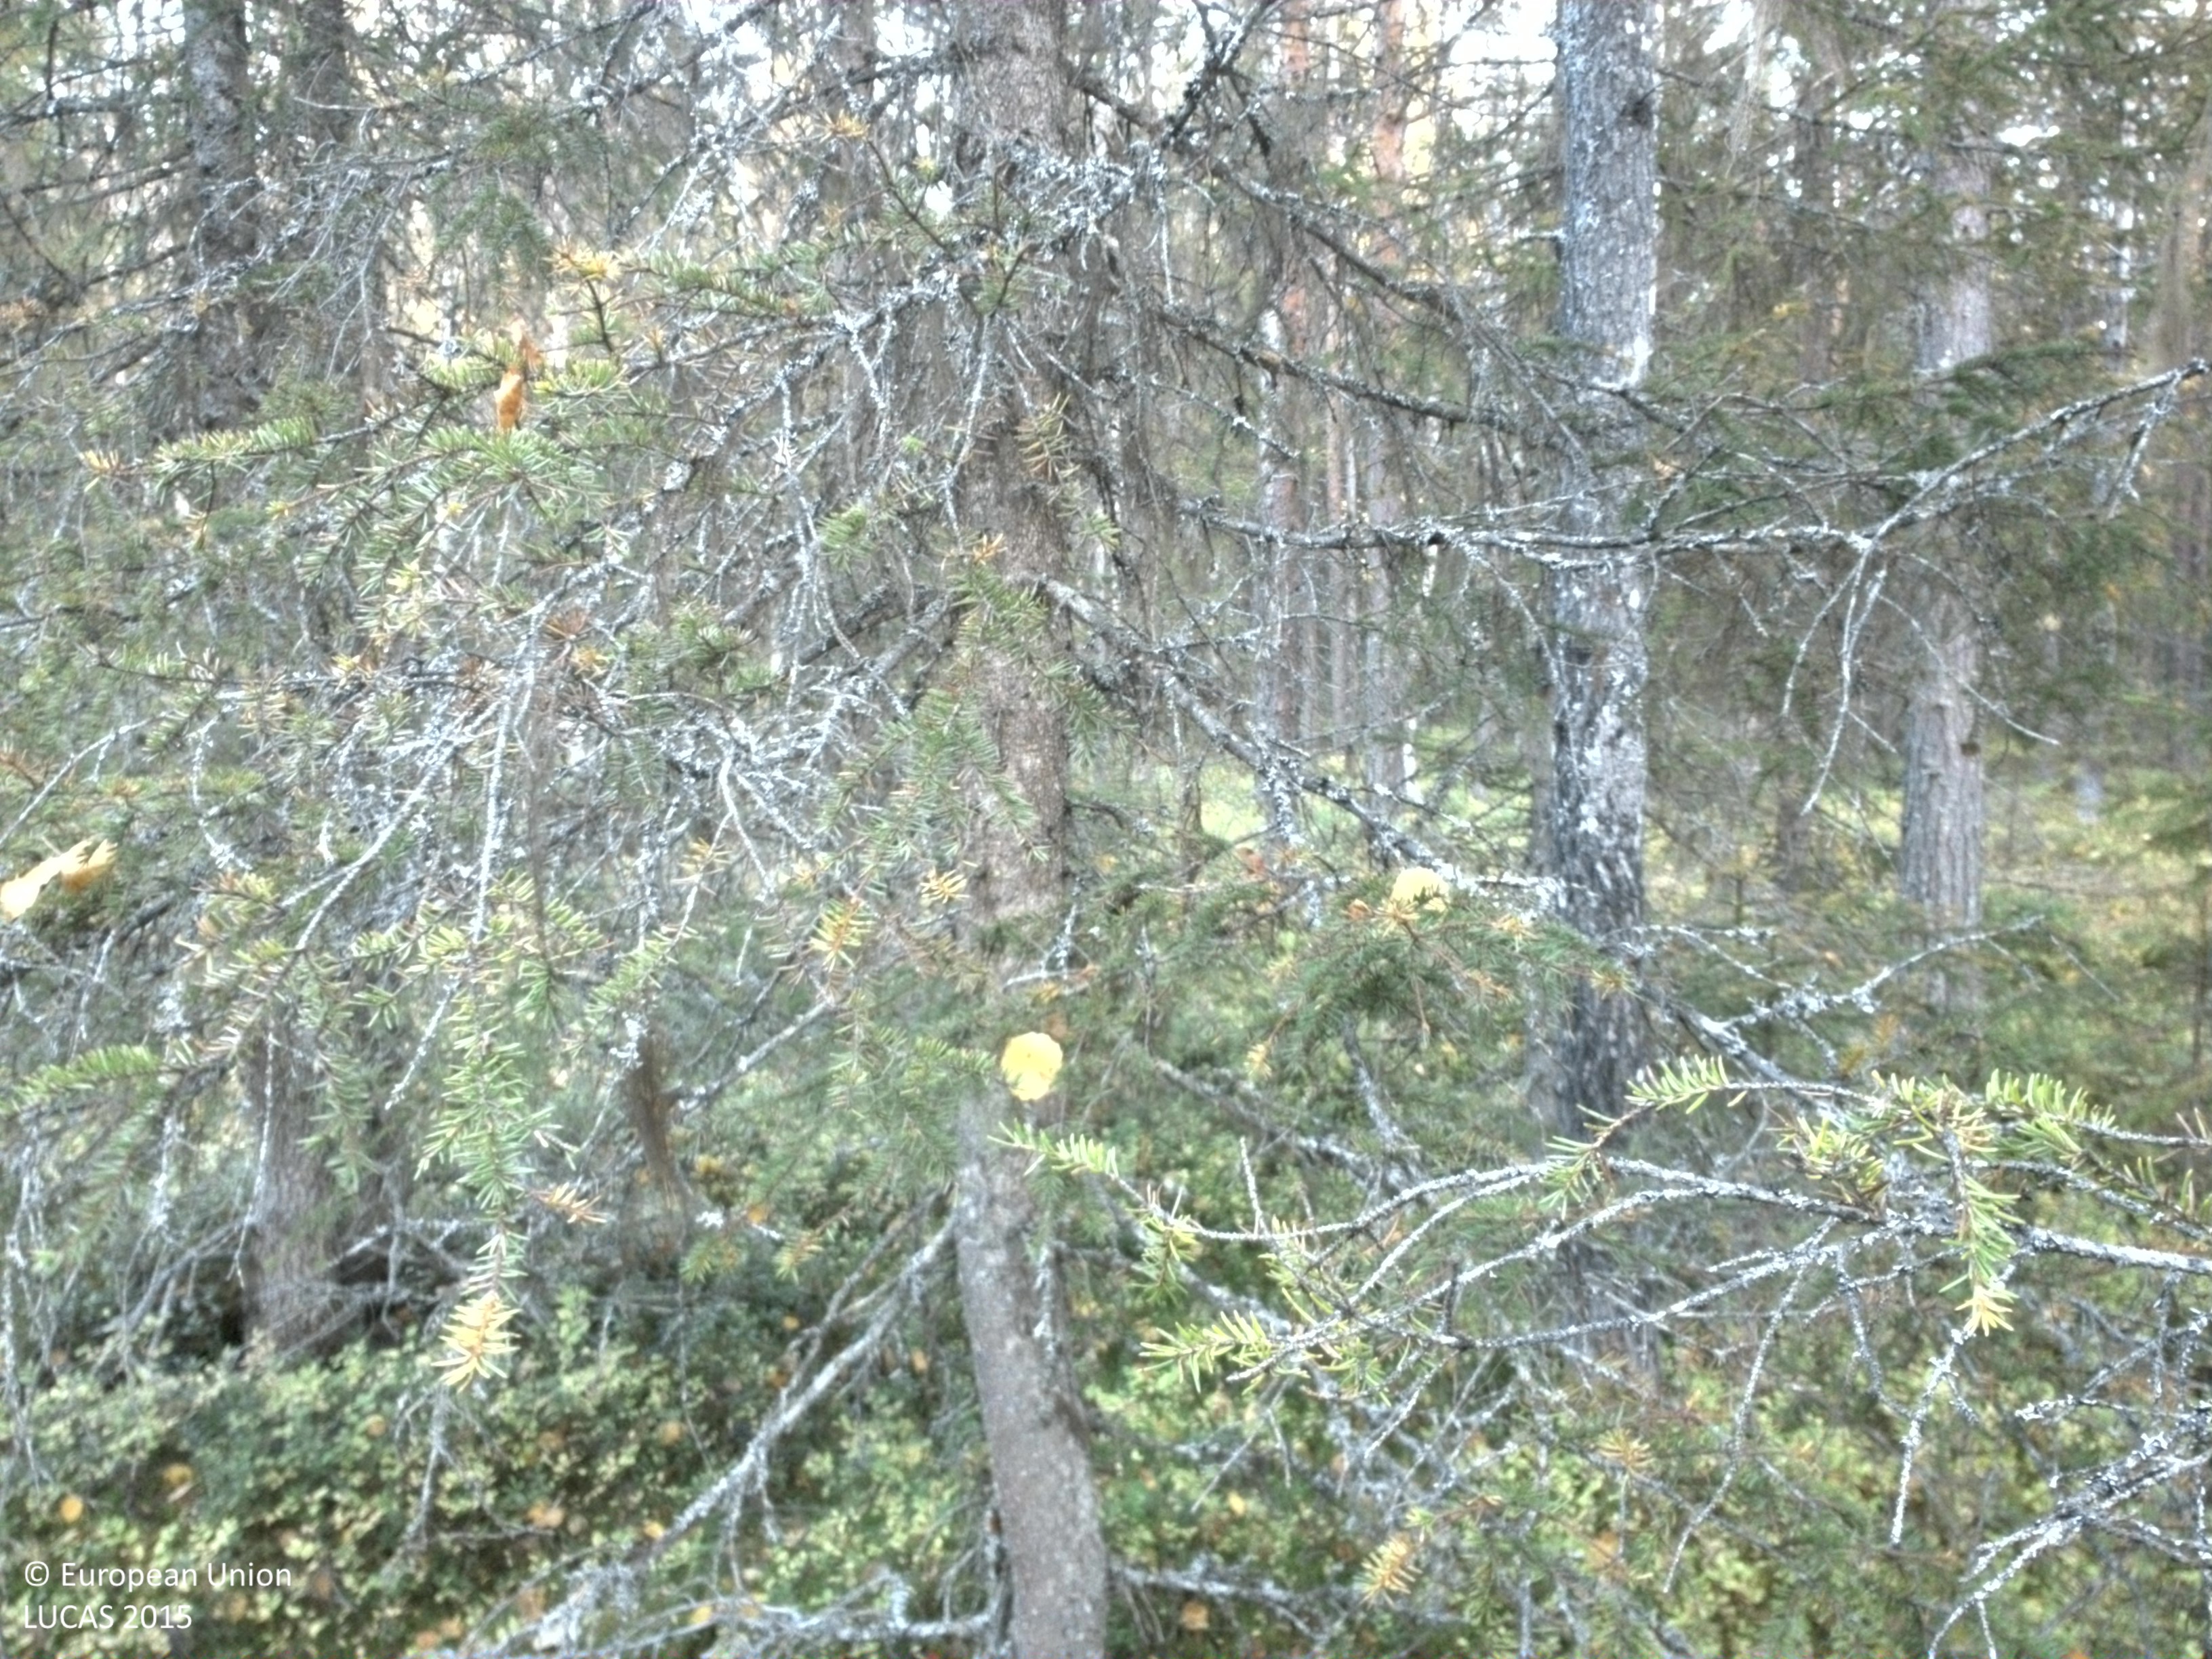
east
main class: Woodland
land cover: Other mixed woodland
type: boreal forest
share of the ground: 25 - 50 %
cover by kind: shrubs 40 %, broadleaved forest trees 25 %, lichens and mosses 20 %, coniferous forest trees 10 %, herbaceous plants 5 %
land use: Forestry
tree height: > 5 m
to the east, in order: Other mixed woodland; Tracks; Other mixed woodland; Spruce dominated mixed woodland
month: September
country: SE
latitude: 64.9999
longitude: 17.5343
